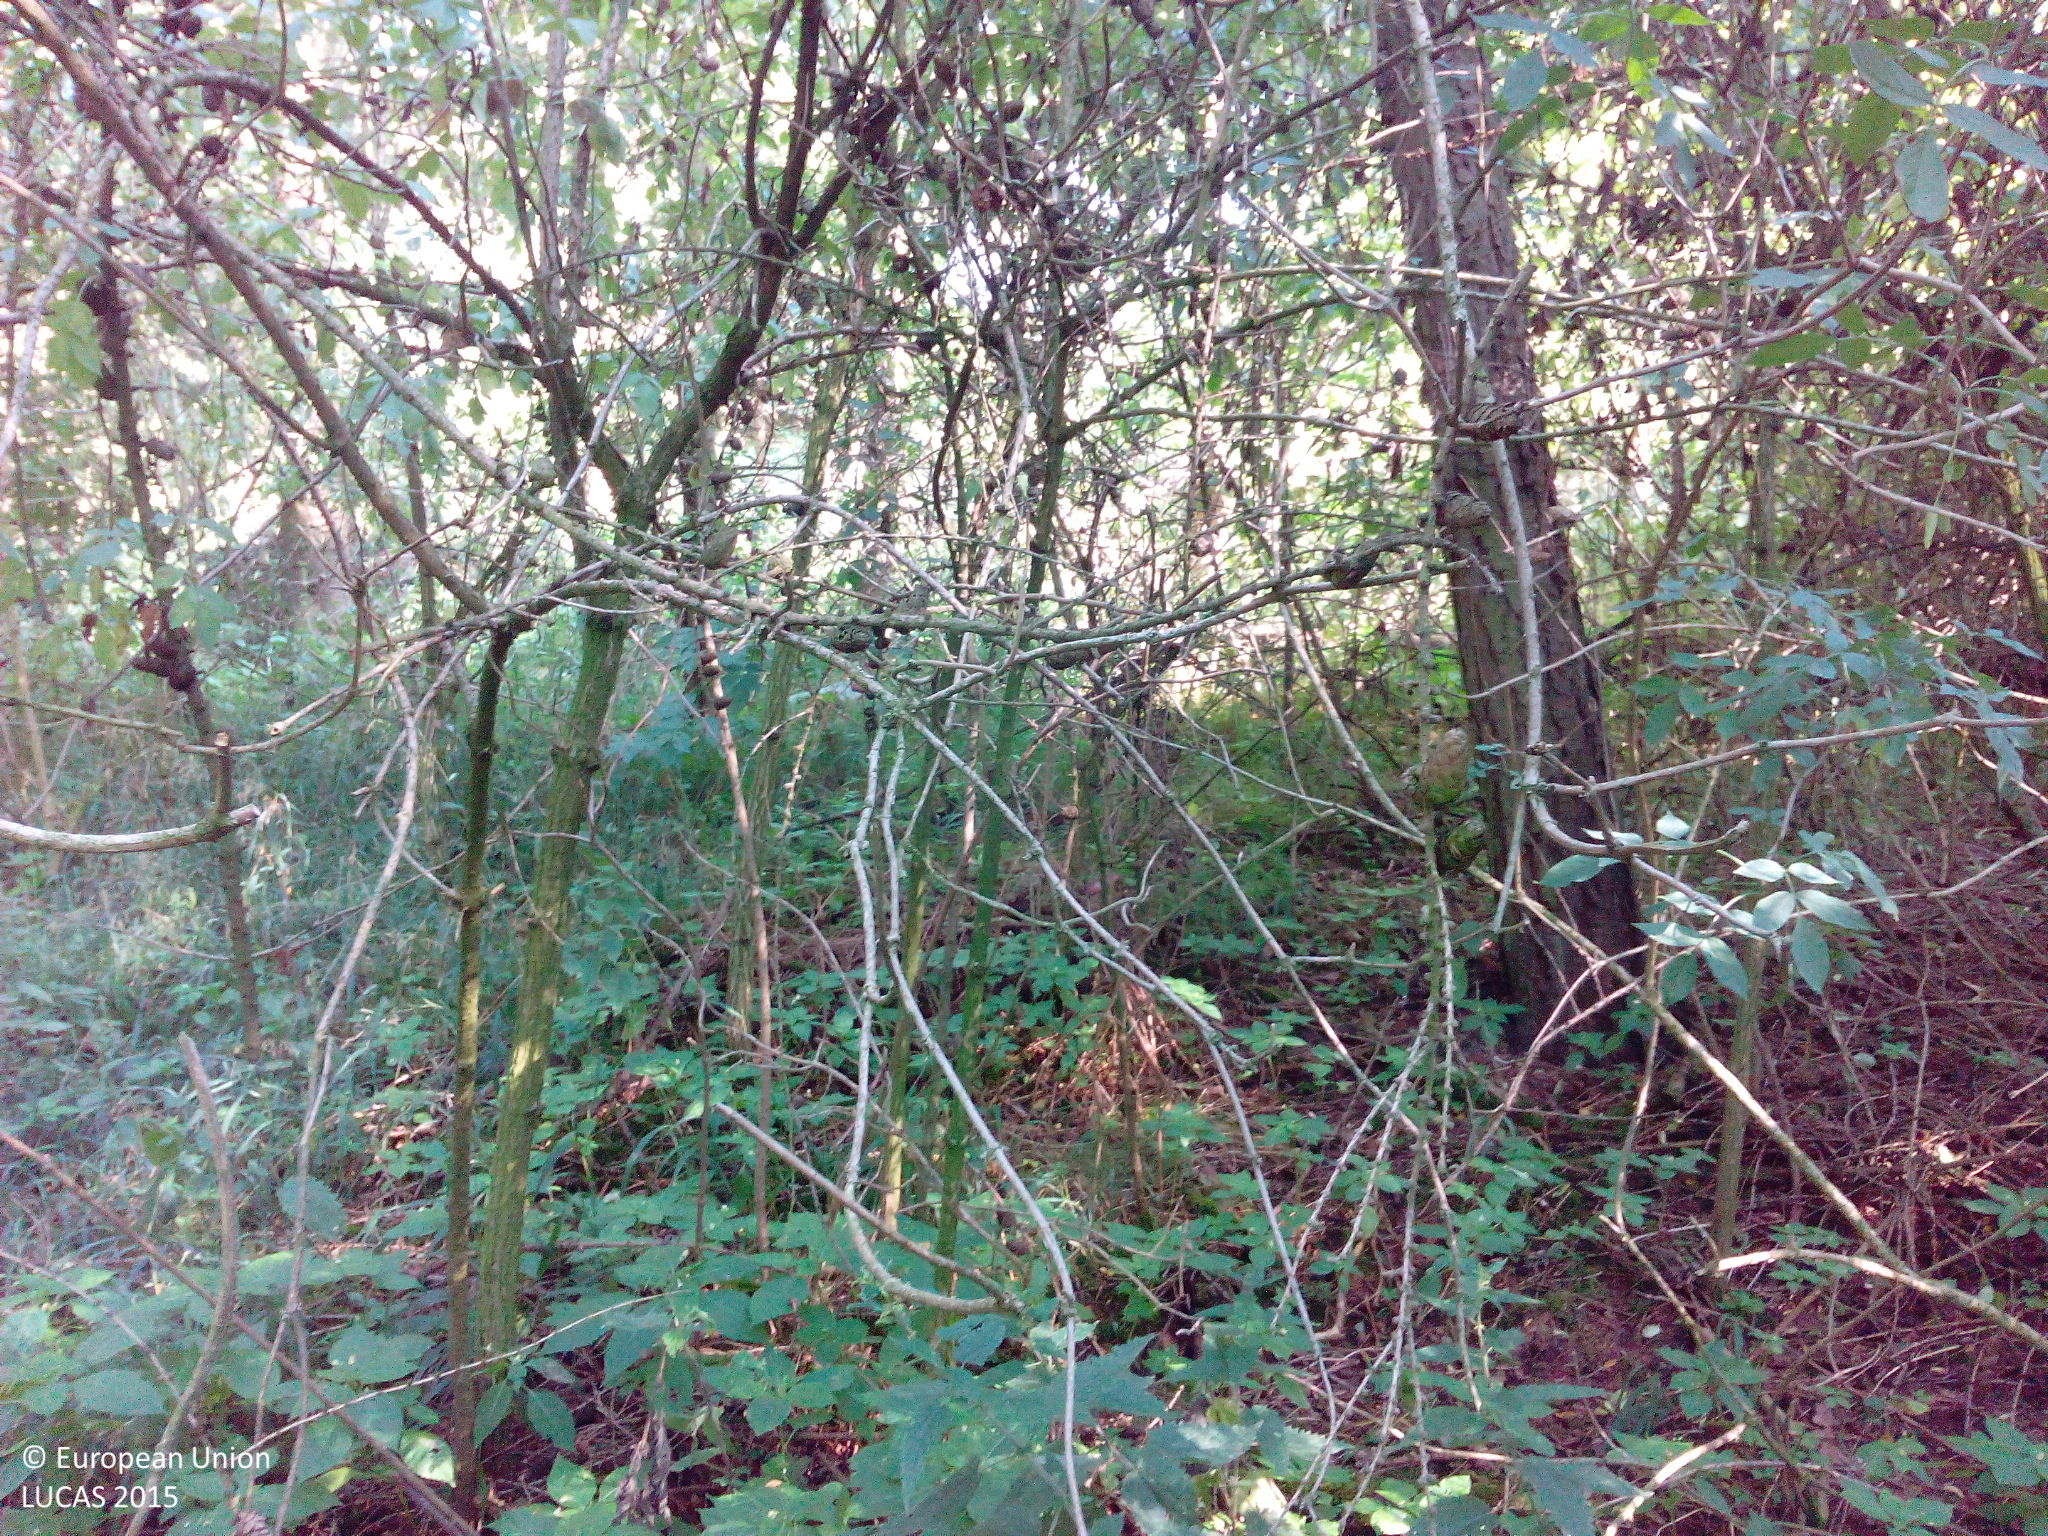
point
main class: Woodland
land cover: Other coniferous woodland
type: hemiboreal forest and nemoral coniferous forest and mixed broadleaved-coniferous forest
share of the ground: > 75 %
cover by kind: coniferous forest trees 75 %, broadleaved forest trees 10 %, shrubs 10 %, herbaceous plants 5 %
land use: Forestry
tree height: > 5 m
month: August
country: DE
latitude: 53.4923
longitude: 13.6023
